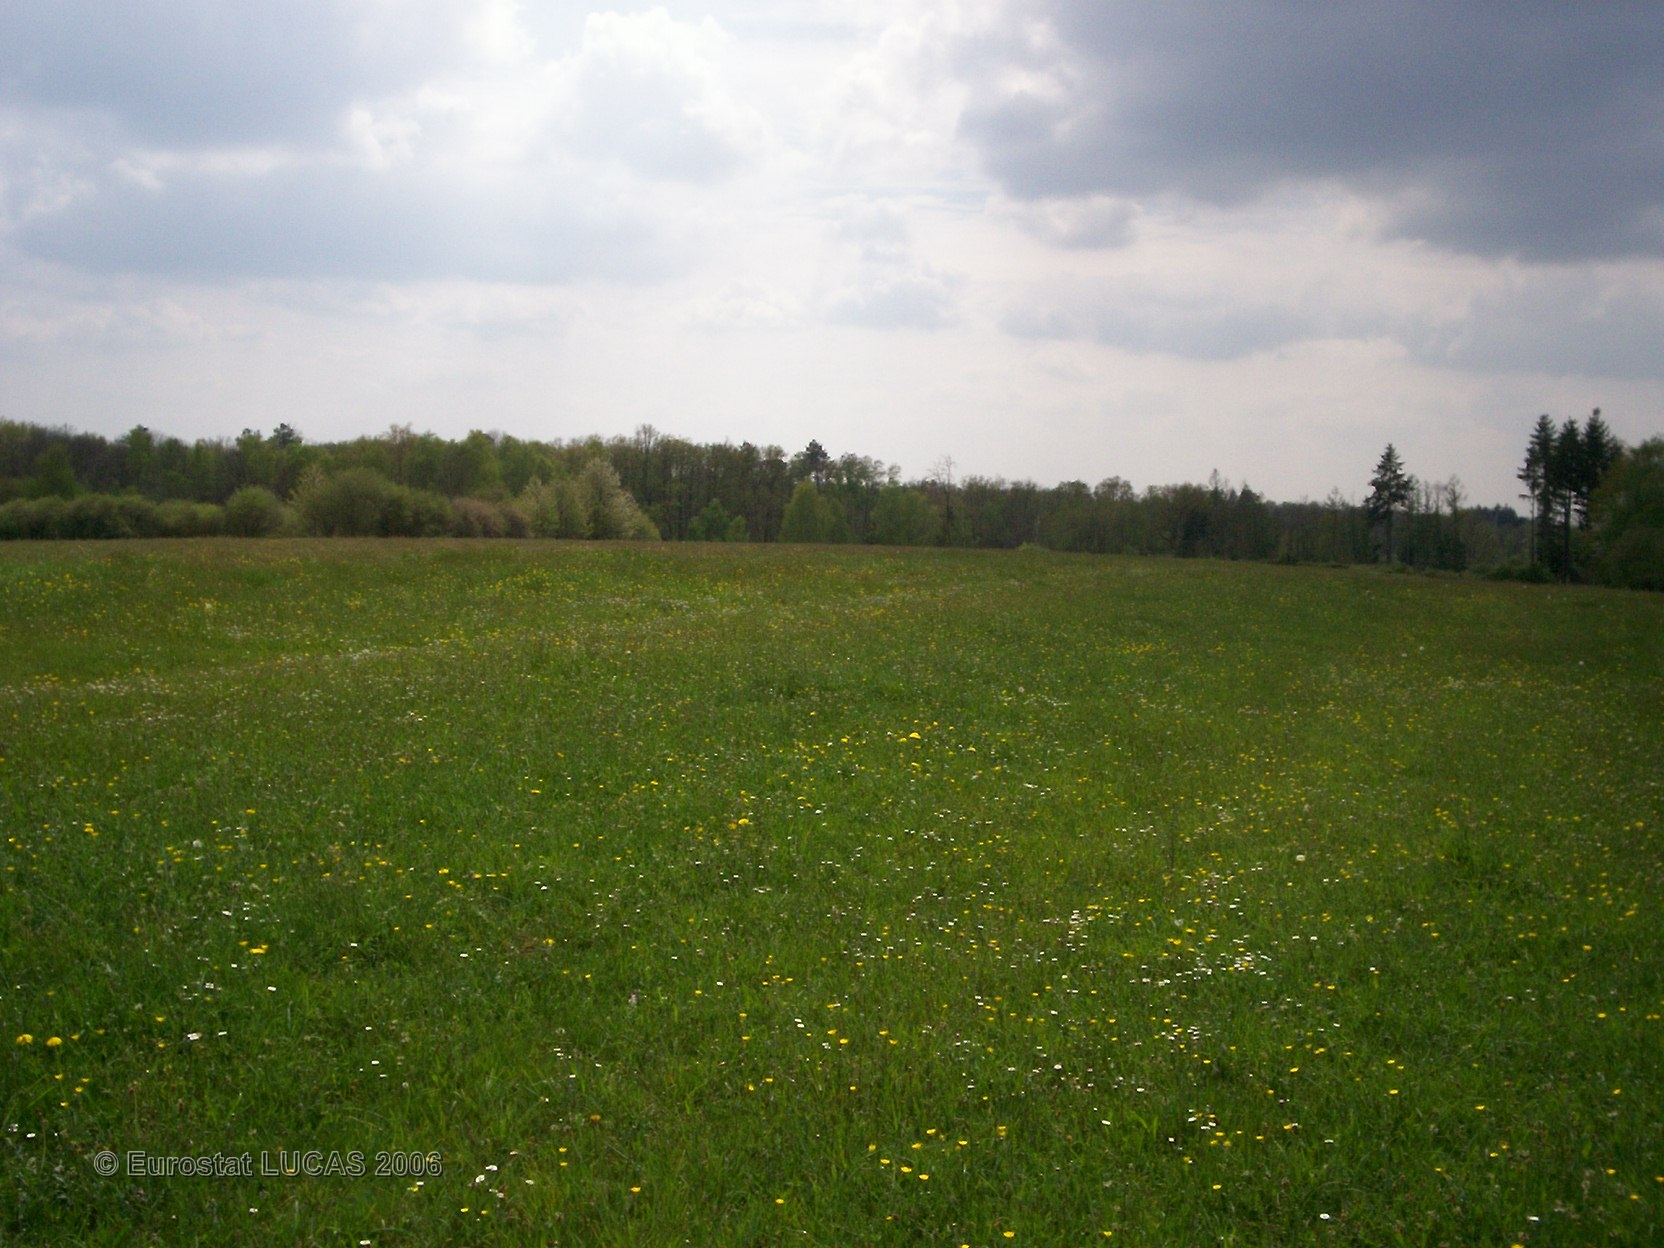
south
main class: Grassland
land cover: Grassland without tree/shrub cover
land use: Agriculture (excluding fallow land and kitchen gardens)
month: April
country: FR
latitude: 45.5734
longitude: 0.8010
